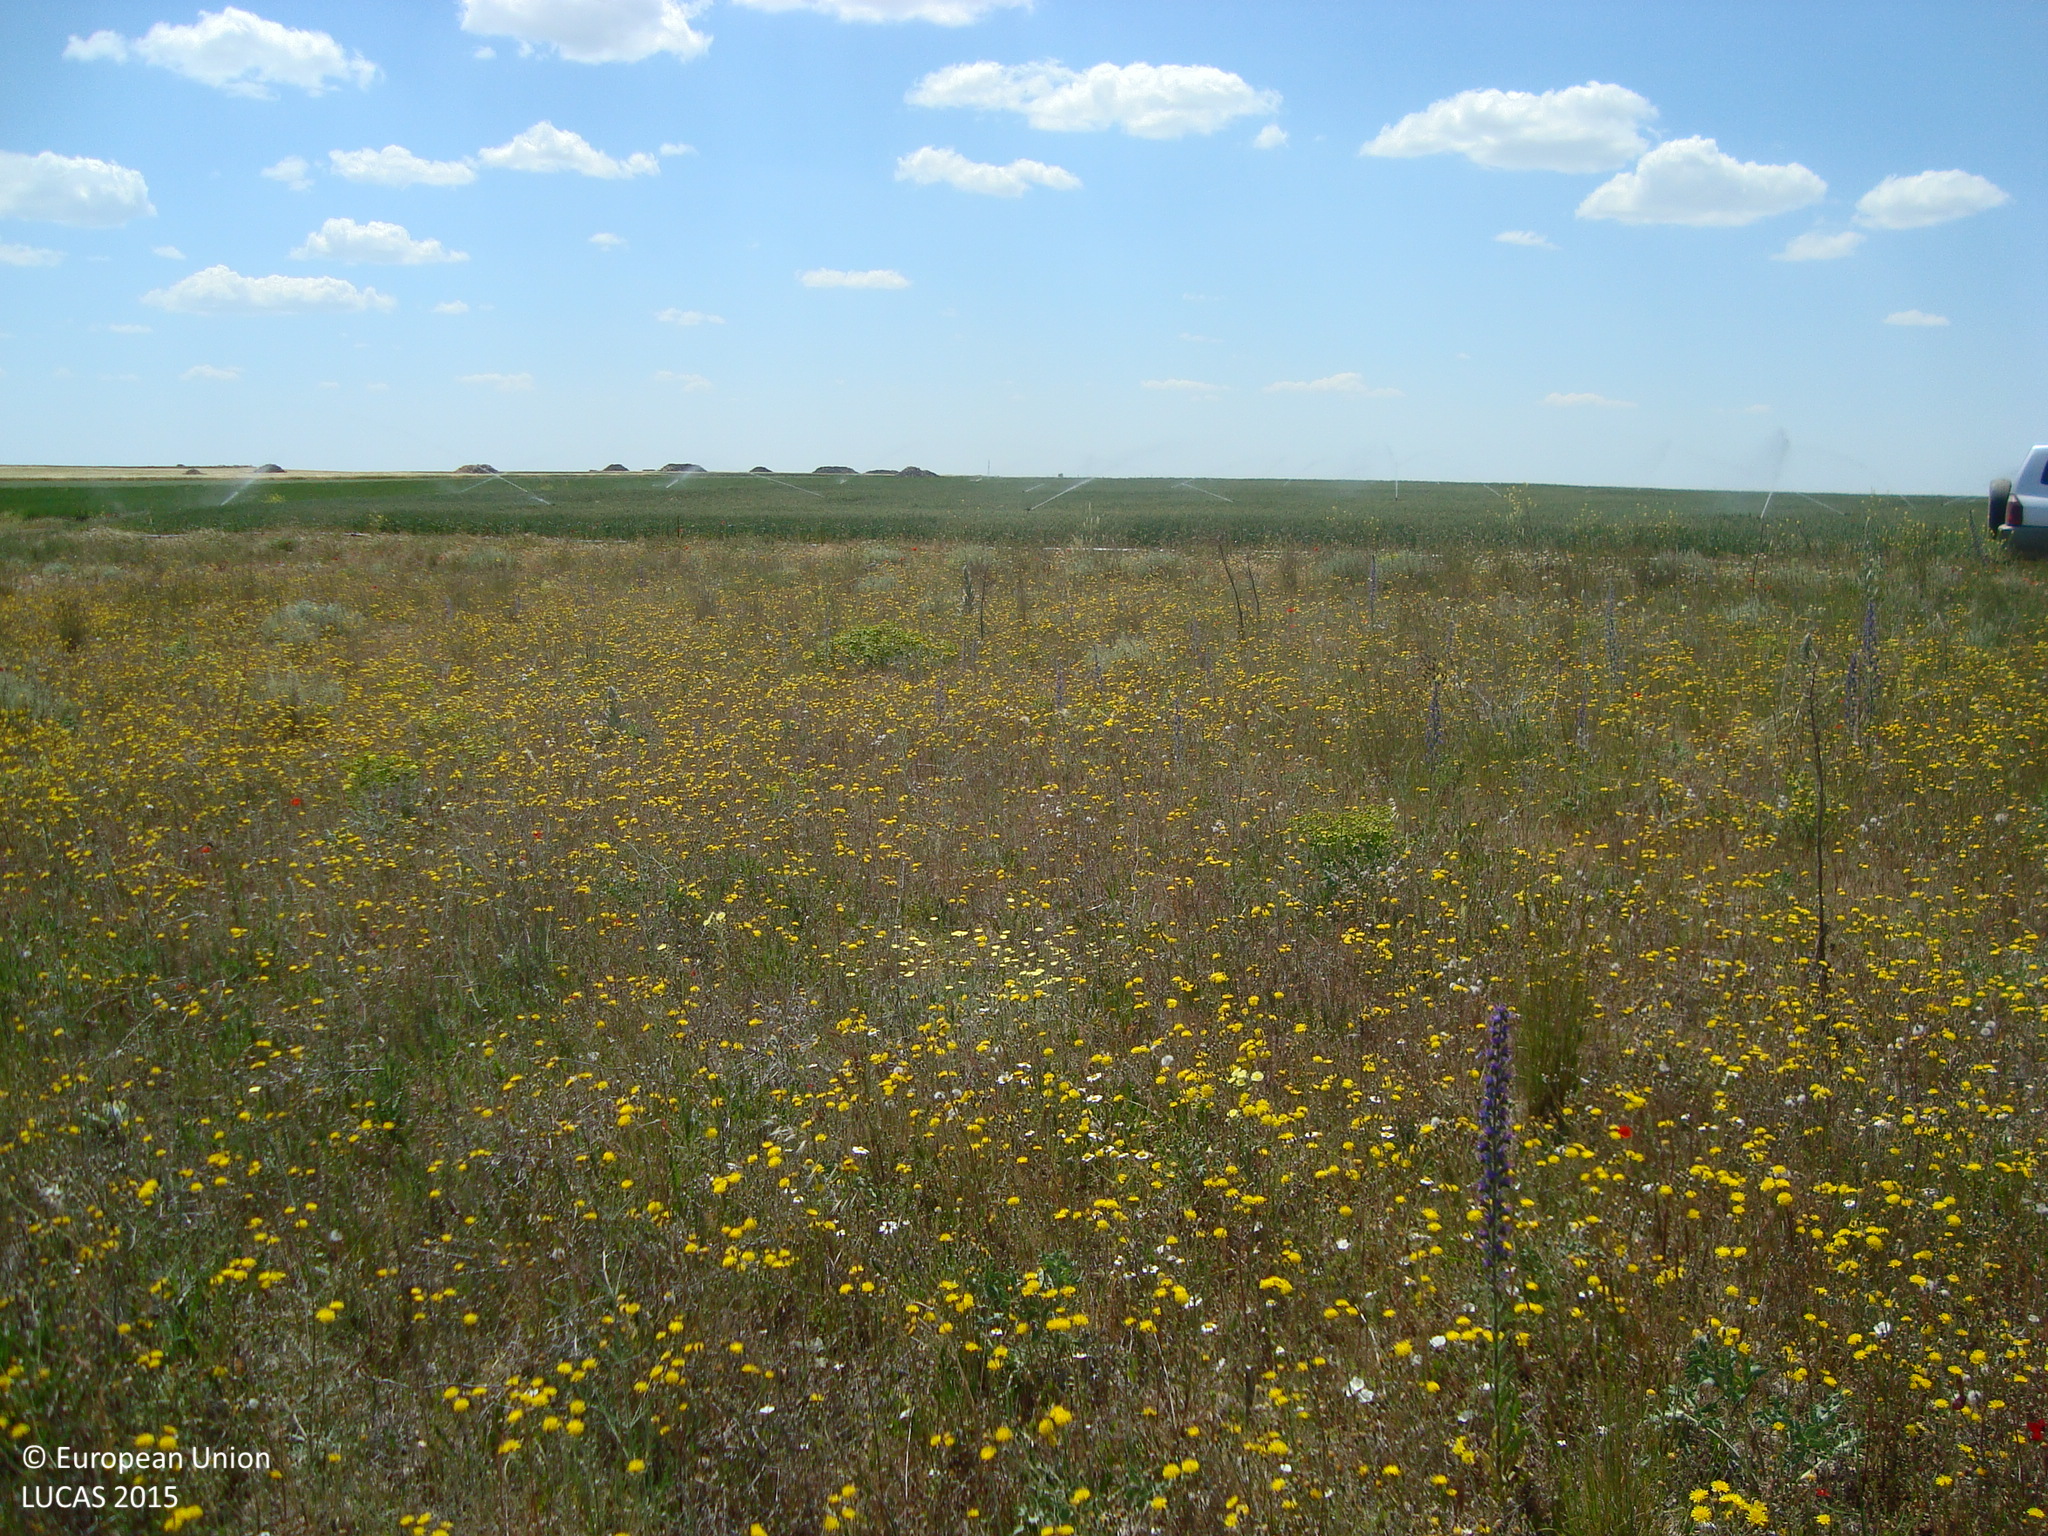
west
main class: Grassland
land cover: Grassland without tree/shrub cover
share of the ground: > 75 %
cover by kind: herbaceous plants 95 %, unconsolidated bare surface 5 %
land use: Abandoned areas
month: May
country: ES
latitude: 41.5594
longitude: -4.0497
